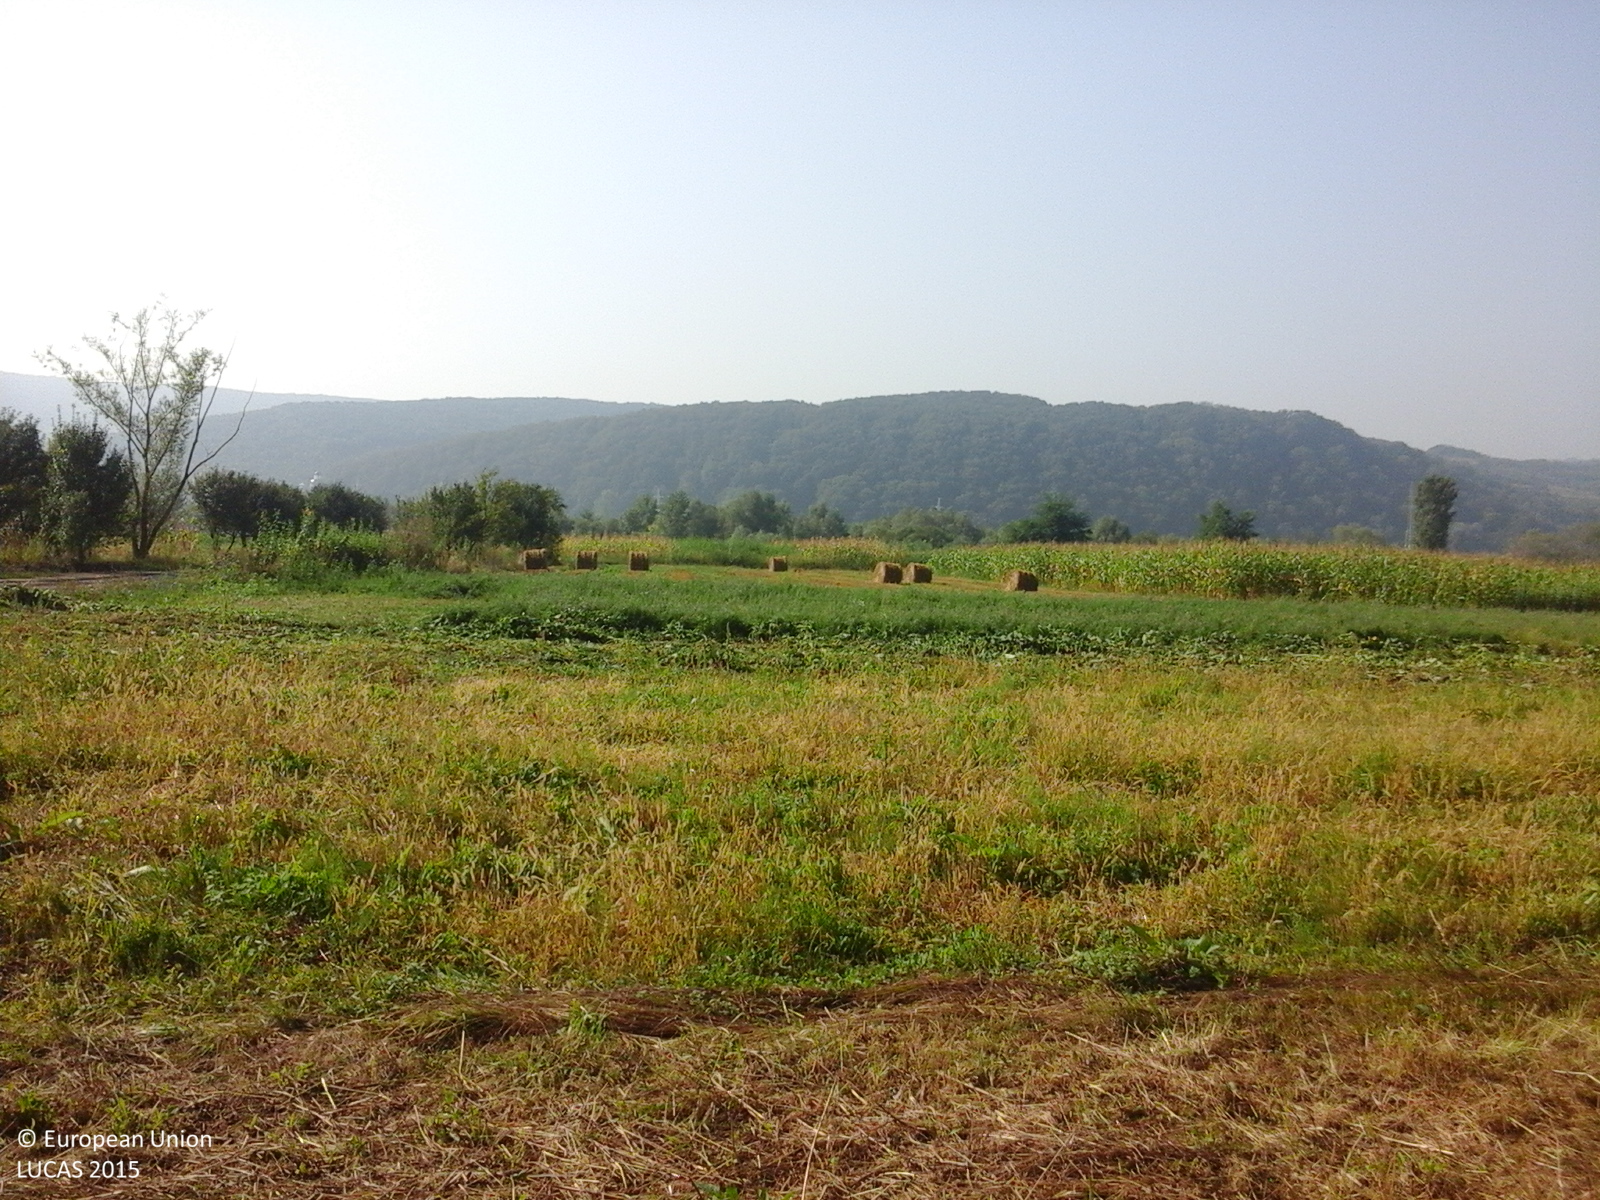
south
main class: Grassland
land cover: Grassland without tree/shrub cover
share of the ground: > 75 %
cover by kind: herbaceous plants 100 %
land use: Agriculture (excluding fallow land and kitchen gardens)
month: September
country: RO
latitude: 47.1789
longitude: 24.1368
